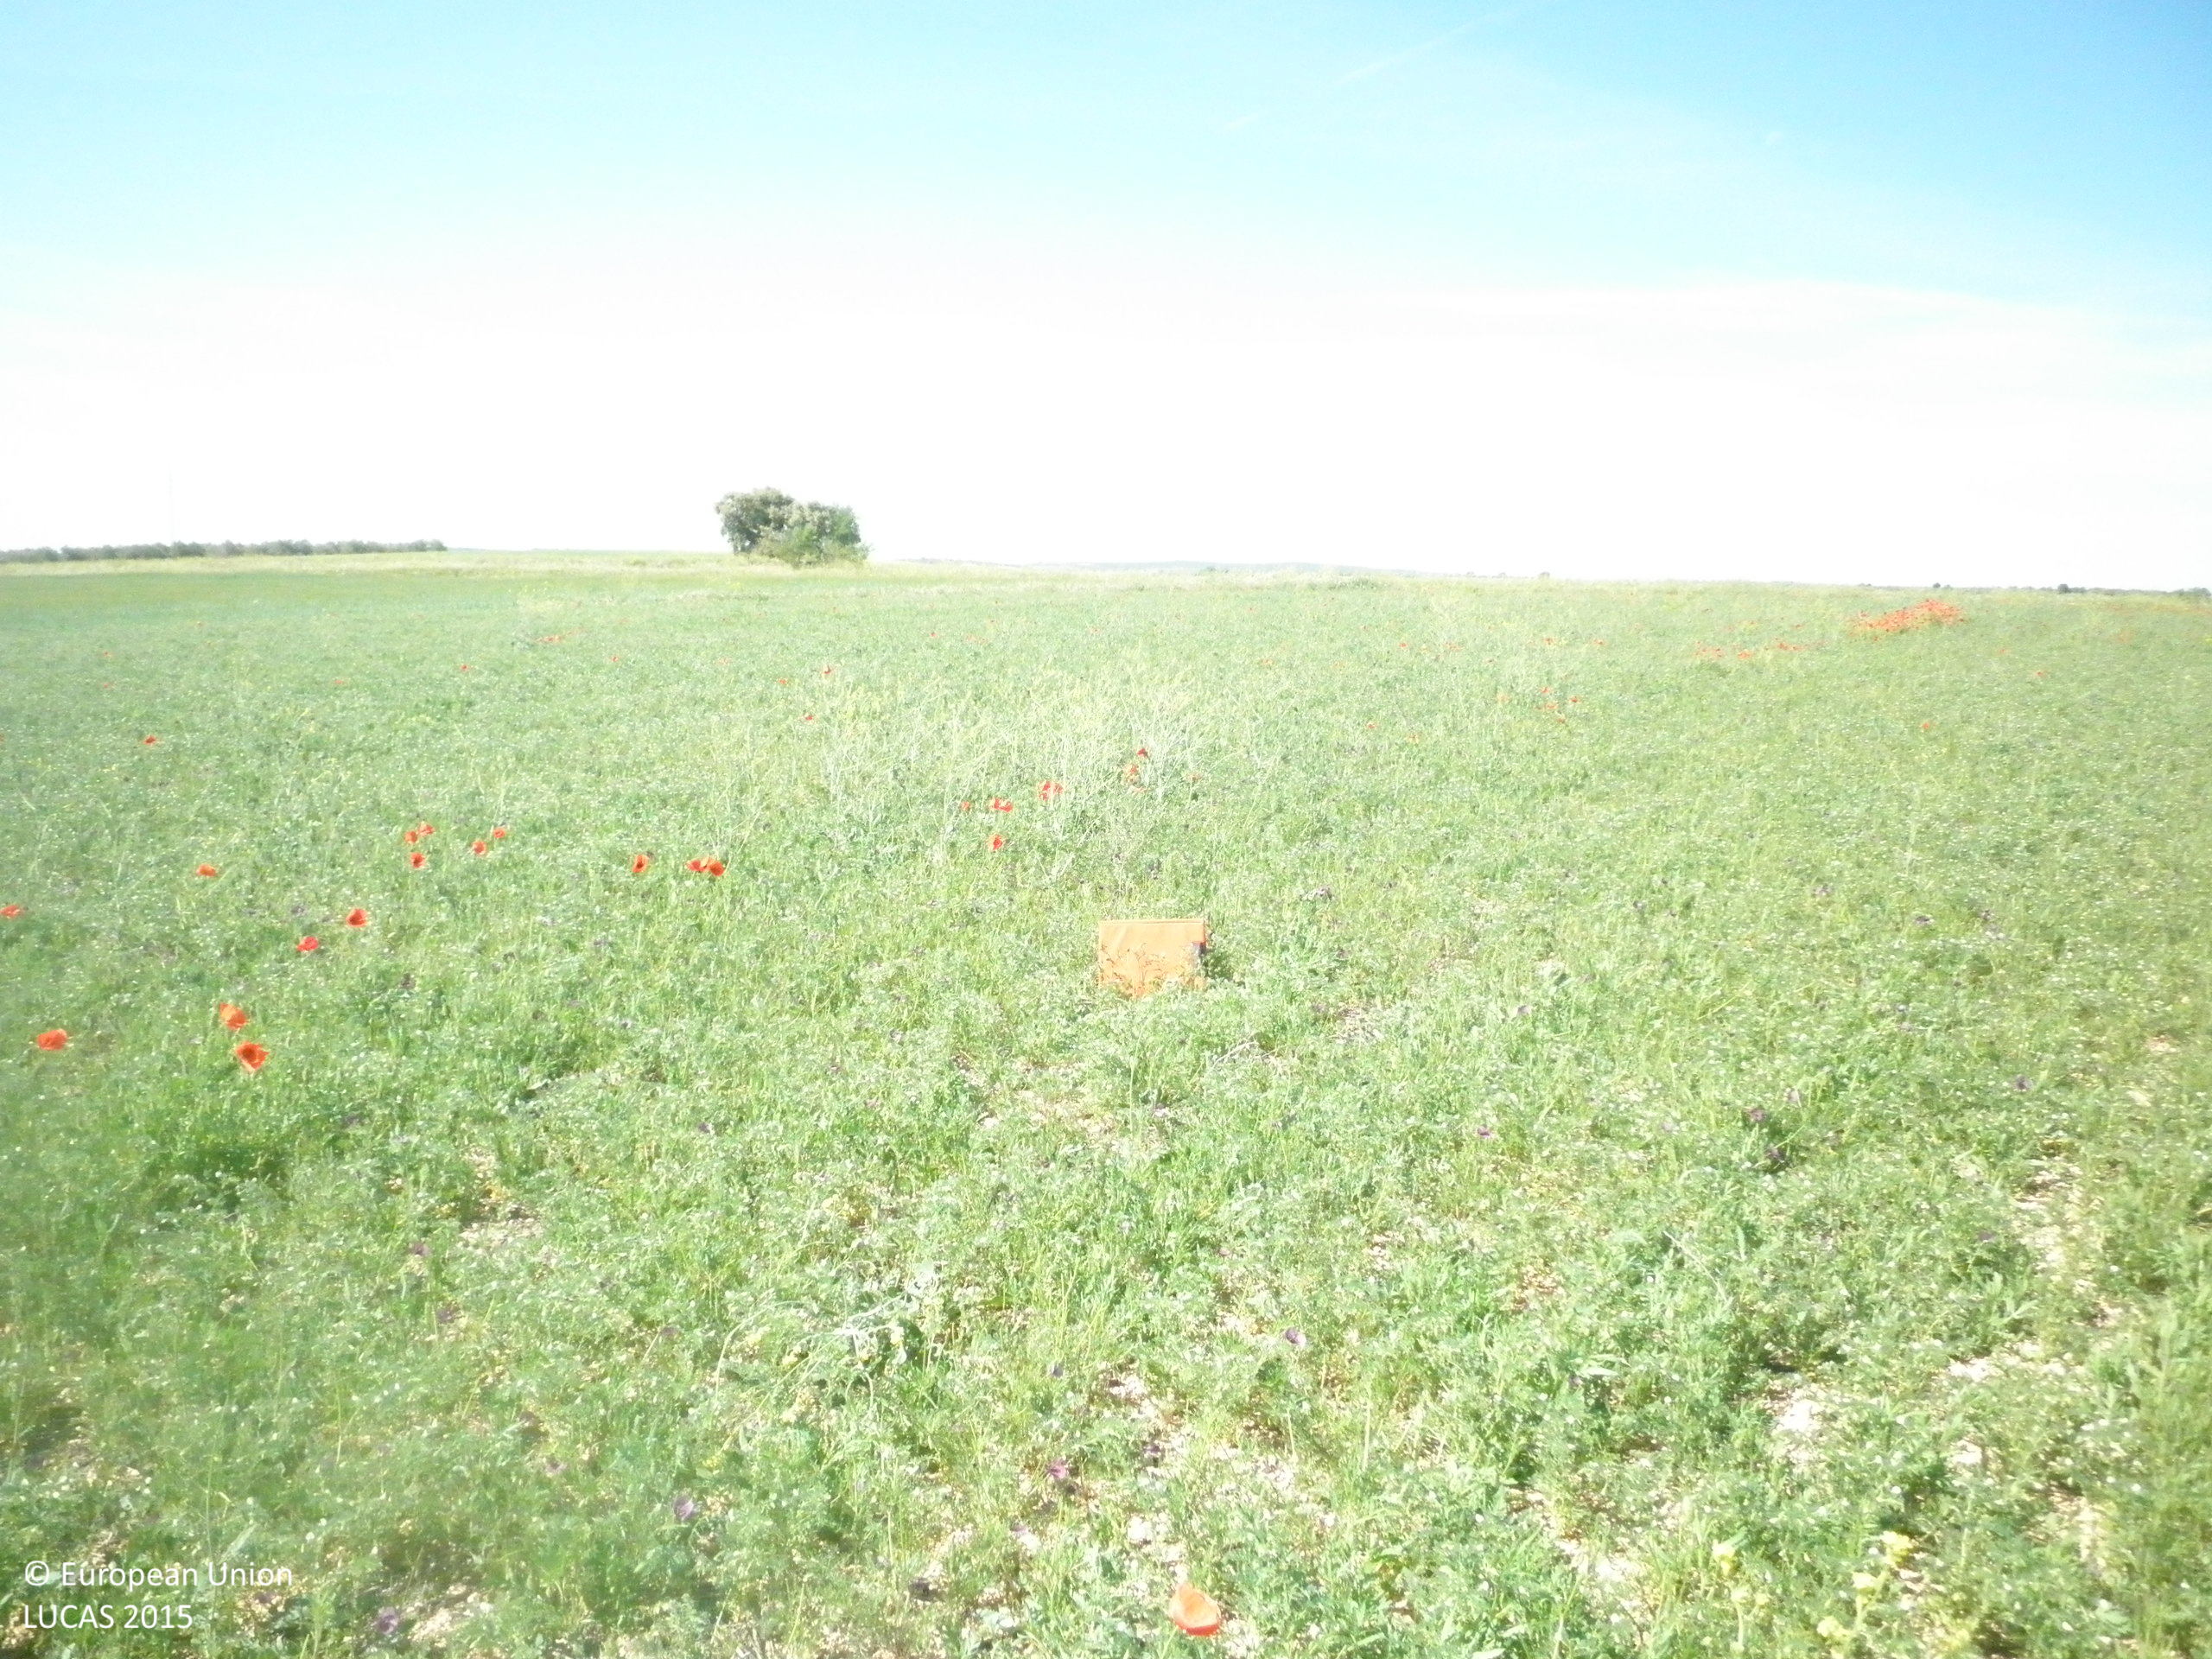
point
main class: Cropland
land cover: Dry pulses
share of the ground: > 75 %
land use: Agriculture (excluding fallow land and kitchen gardens)
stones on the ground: 10 - 25 %
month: May
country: ES
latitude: 39.7220
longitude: -2.7686
